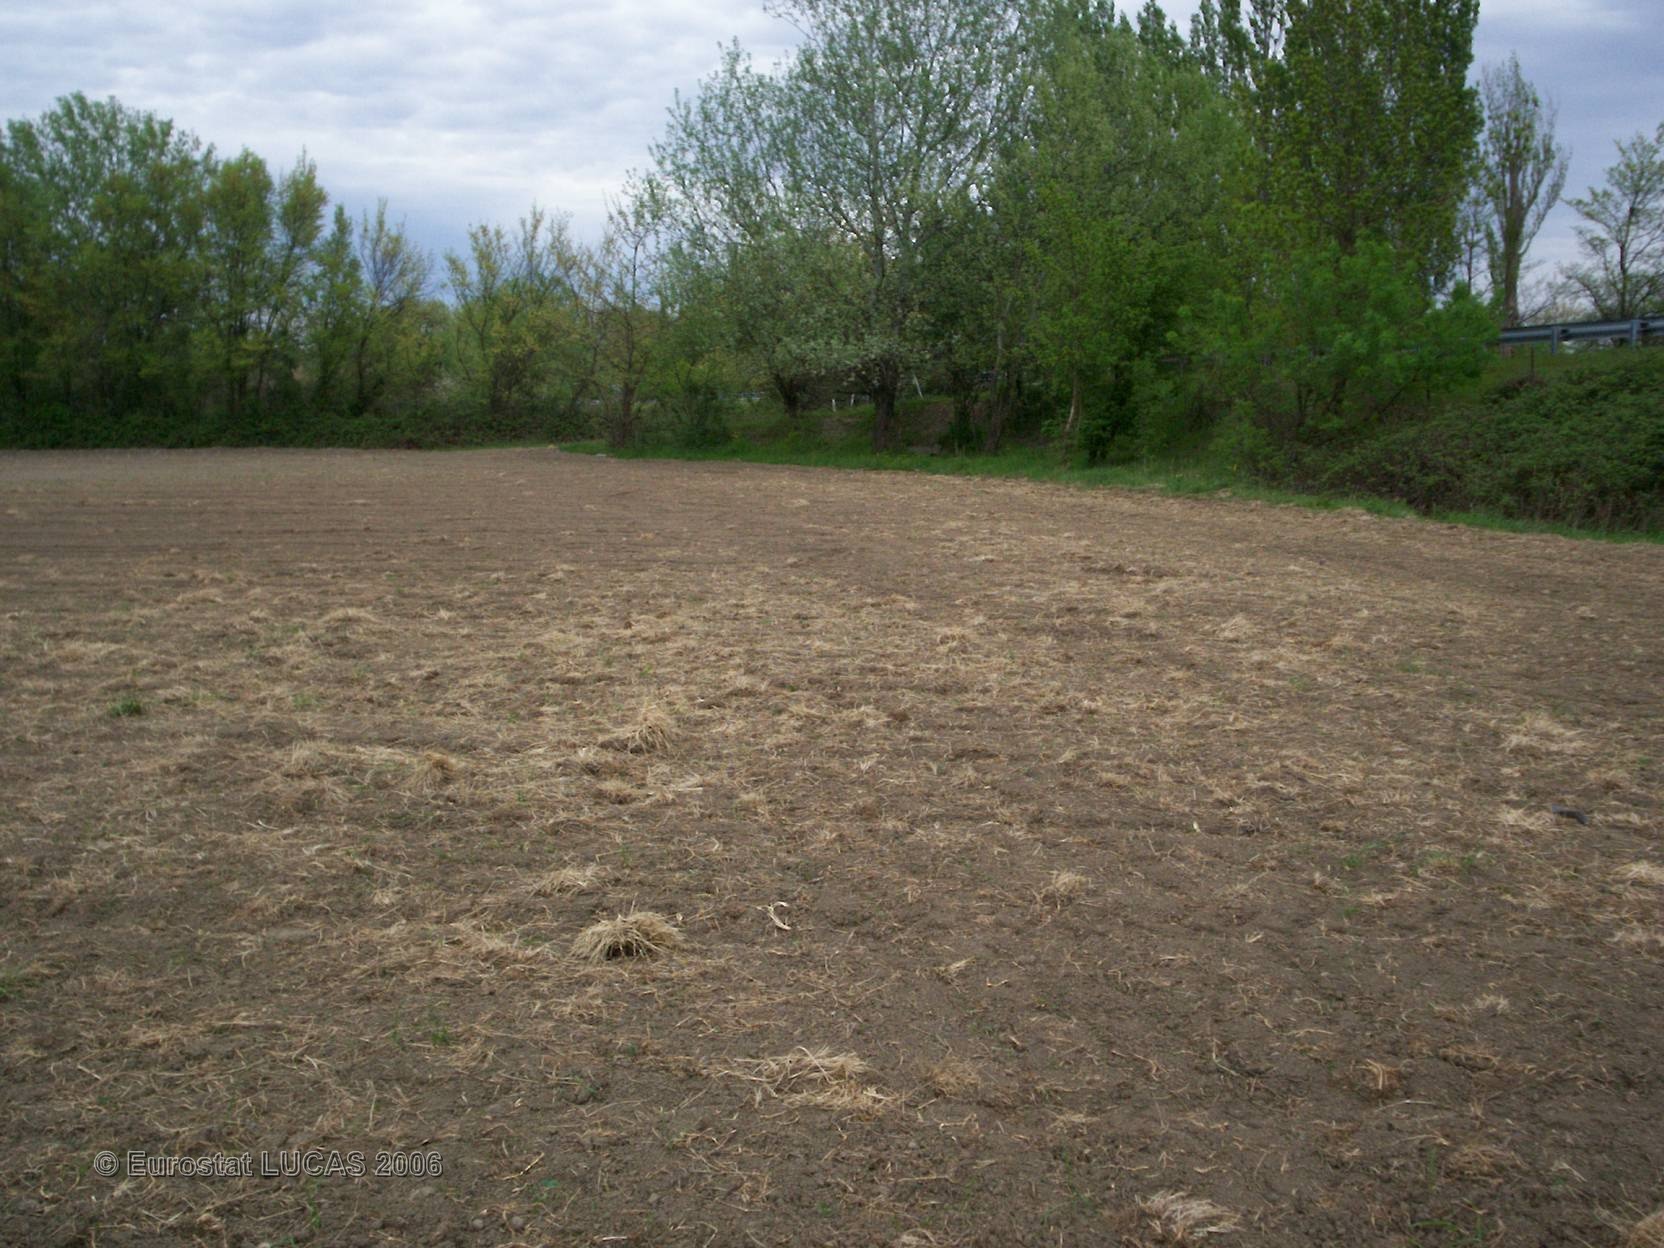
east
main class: Cropland
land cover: Lucerne
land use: Agriculture (excluding fallow land and kitchen gardens)
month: June
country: FR
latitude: 43.8455
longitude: 4.8966
